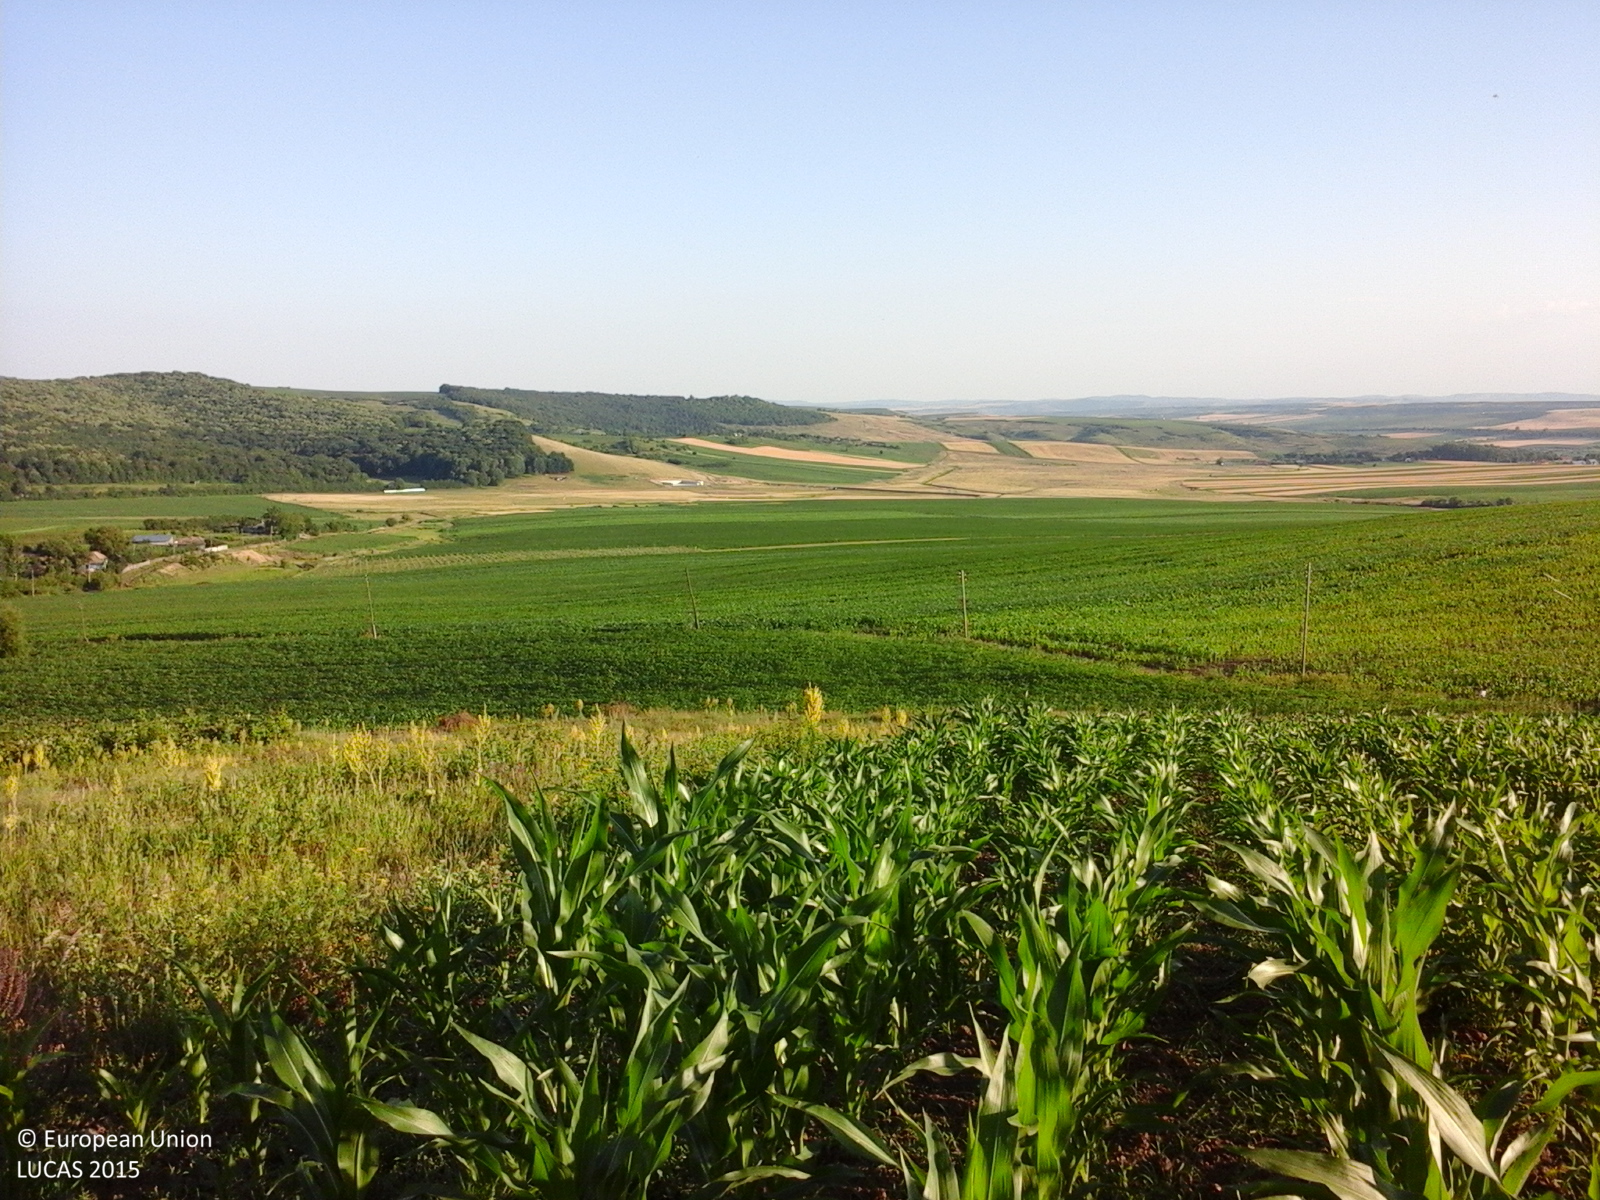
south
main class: Cropland
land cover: Maize
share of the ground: > 75 %
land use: Agriculture (excluding fallow land and kitchen gardens)
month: June
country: RO
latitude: 46.9394
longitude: 27.6017
